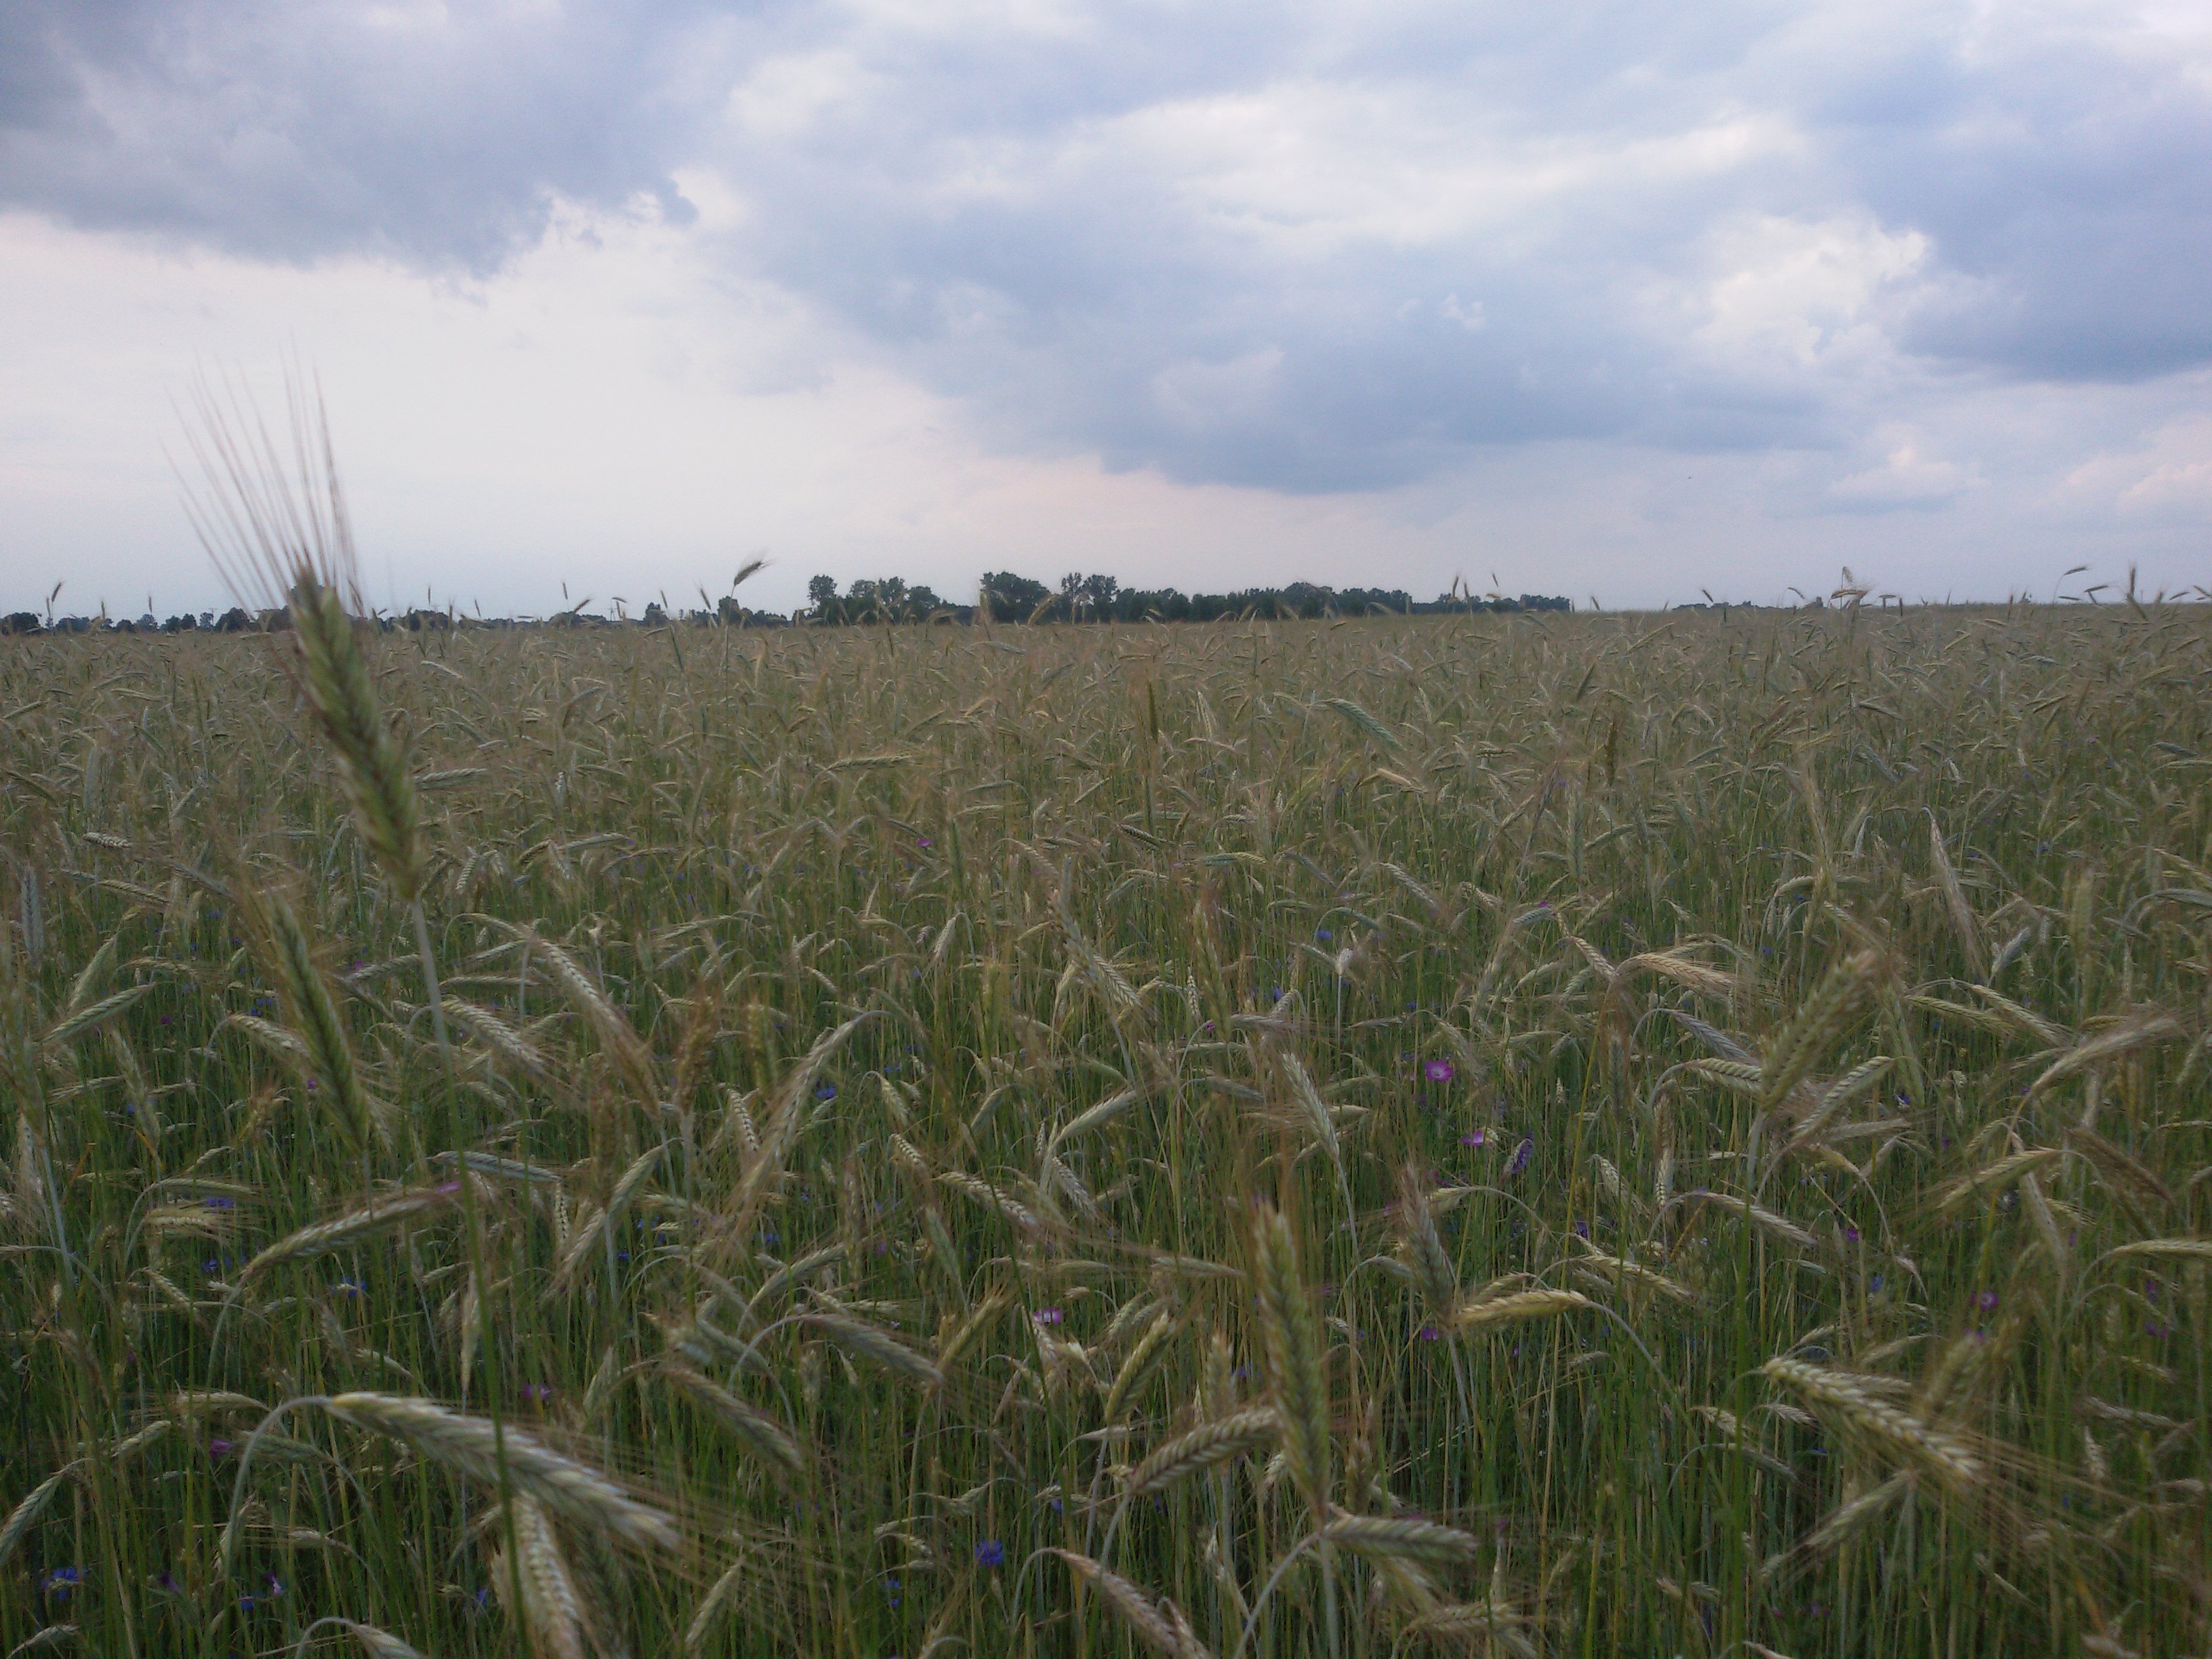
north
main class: Cropland
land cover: Rye
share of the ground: > 75 %
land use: Agriculture (excluding fallow land and kitchen gardens)
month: June
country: PL
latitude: 51.7924
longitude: 23.5845
